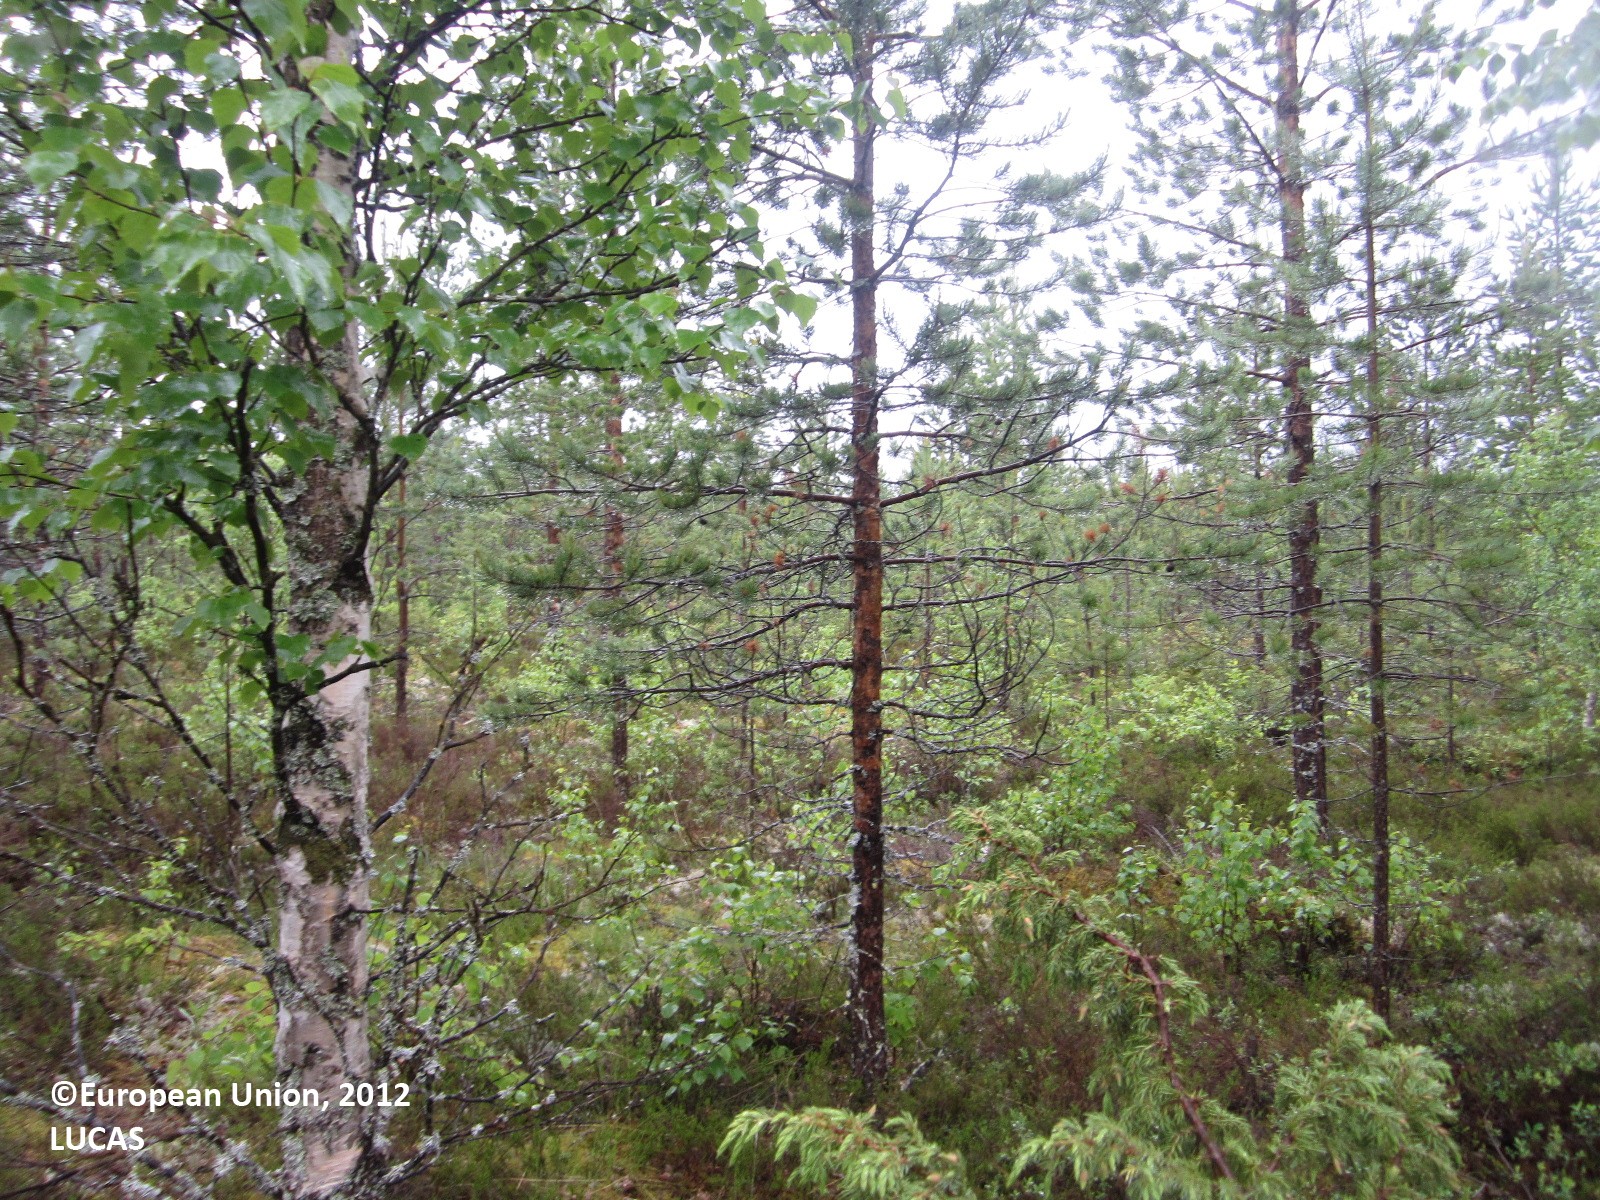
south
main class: Woodland
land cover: Pine dominated coniferous woodland
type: boreal forest
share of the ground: 50 - 75 %
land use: Forestry
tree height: > 5 m
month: June
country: FI
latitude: 64.6626
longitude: 29.2380
